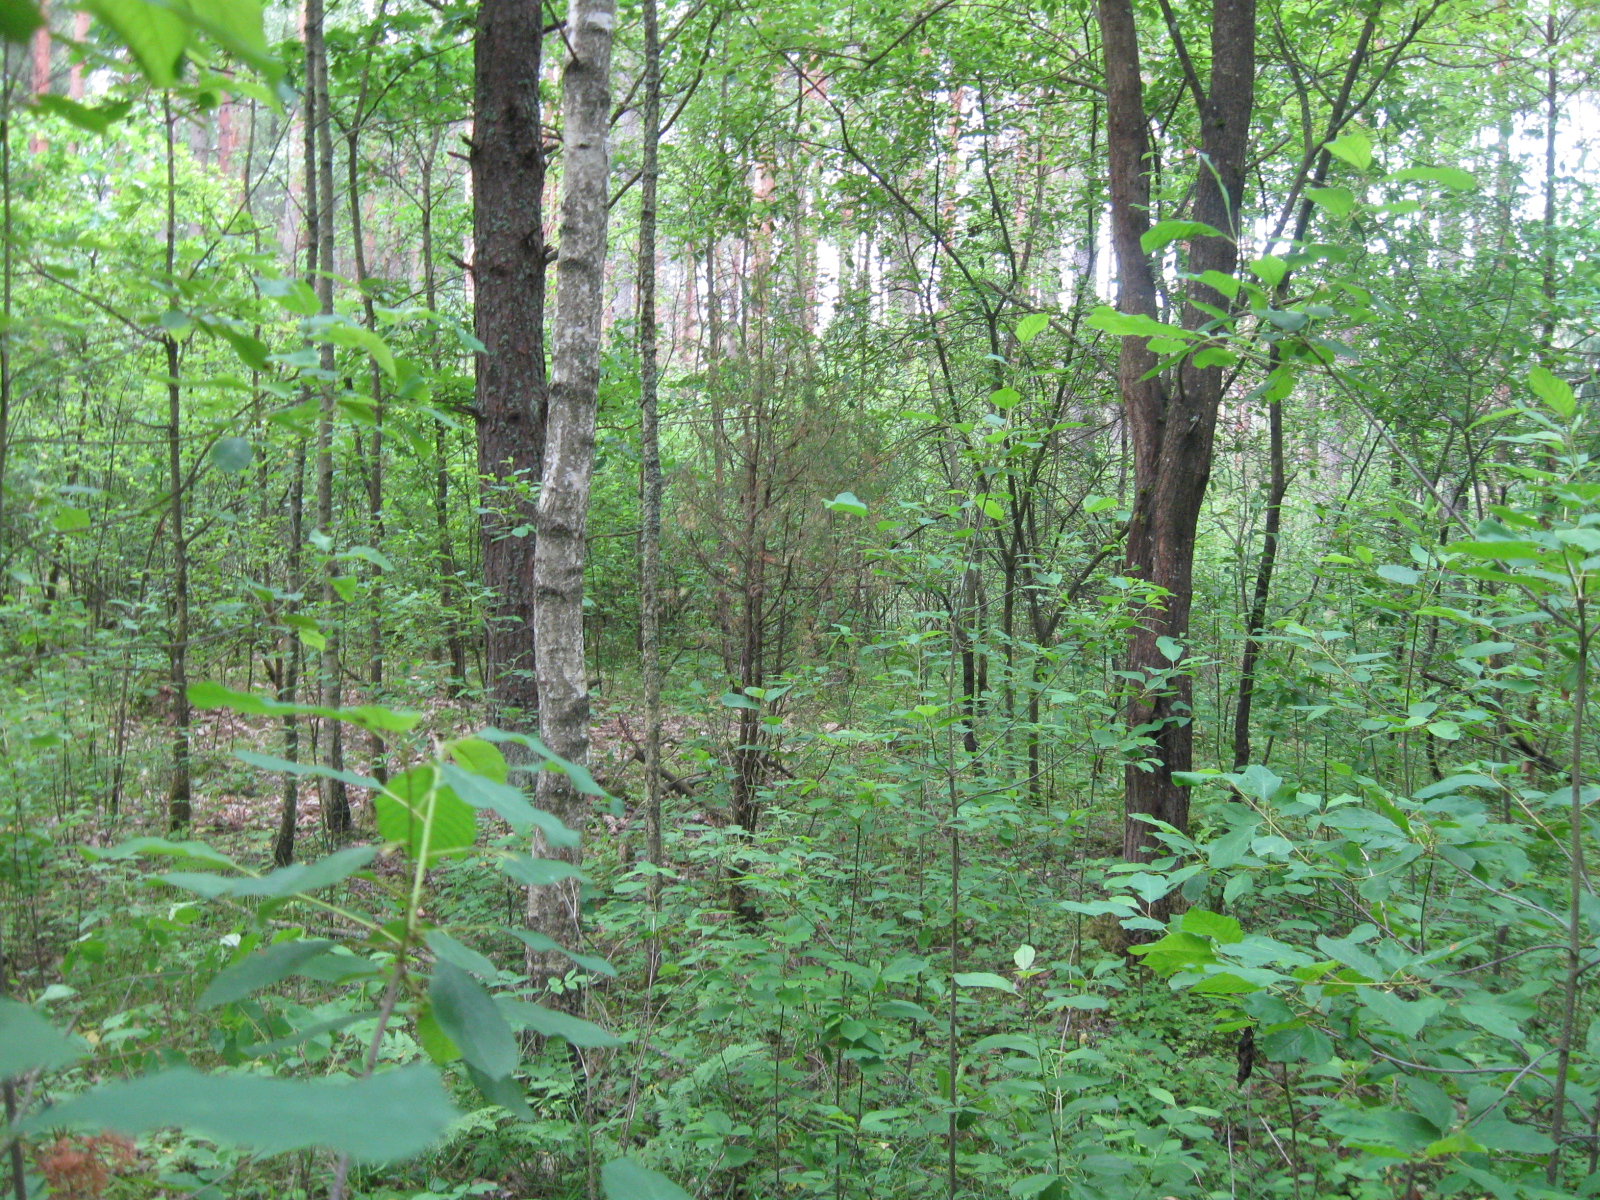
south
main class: Woodland
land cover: Other mixed woodland
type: hemiboreal forest and nemoral coniferous forest and mixed broadleaved-coniferous forest
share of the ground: > 75 %
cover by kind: broadleaved forest trees 55 %, coniferous forest trees 30 %, herbaceous plants 15 %
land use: Forestry
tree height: > 5 m
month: June
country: LT
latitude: 54.4189
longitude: 24.7020
